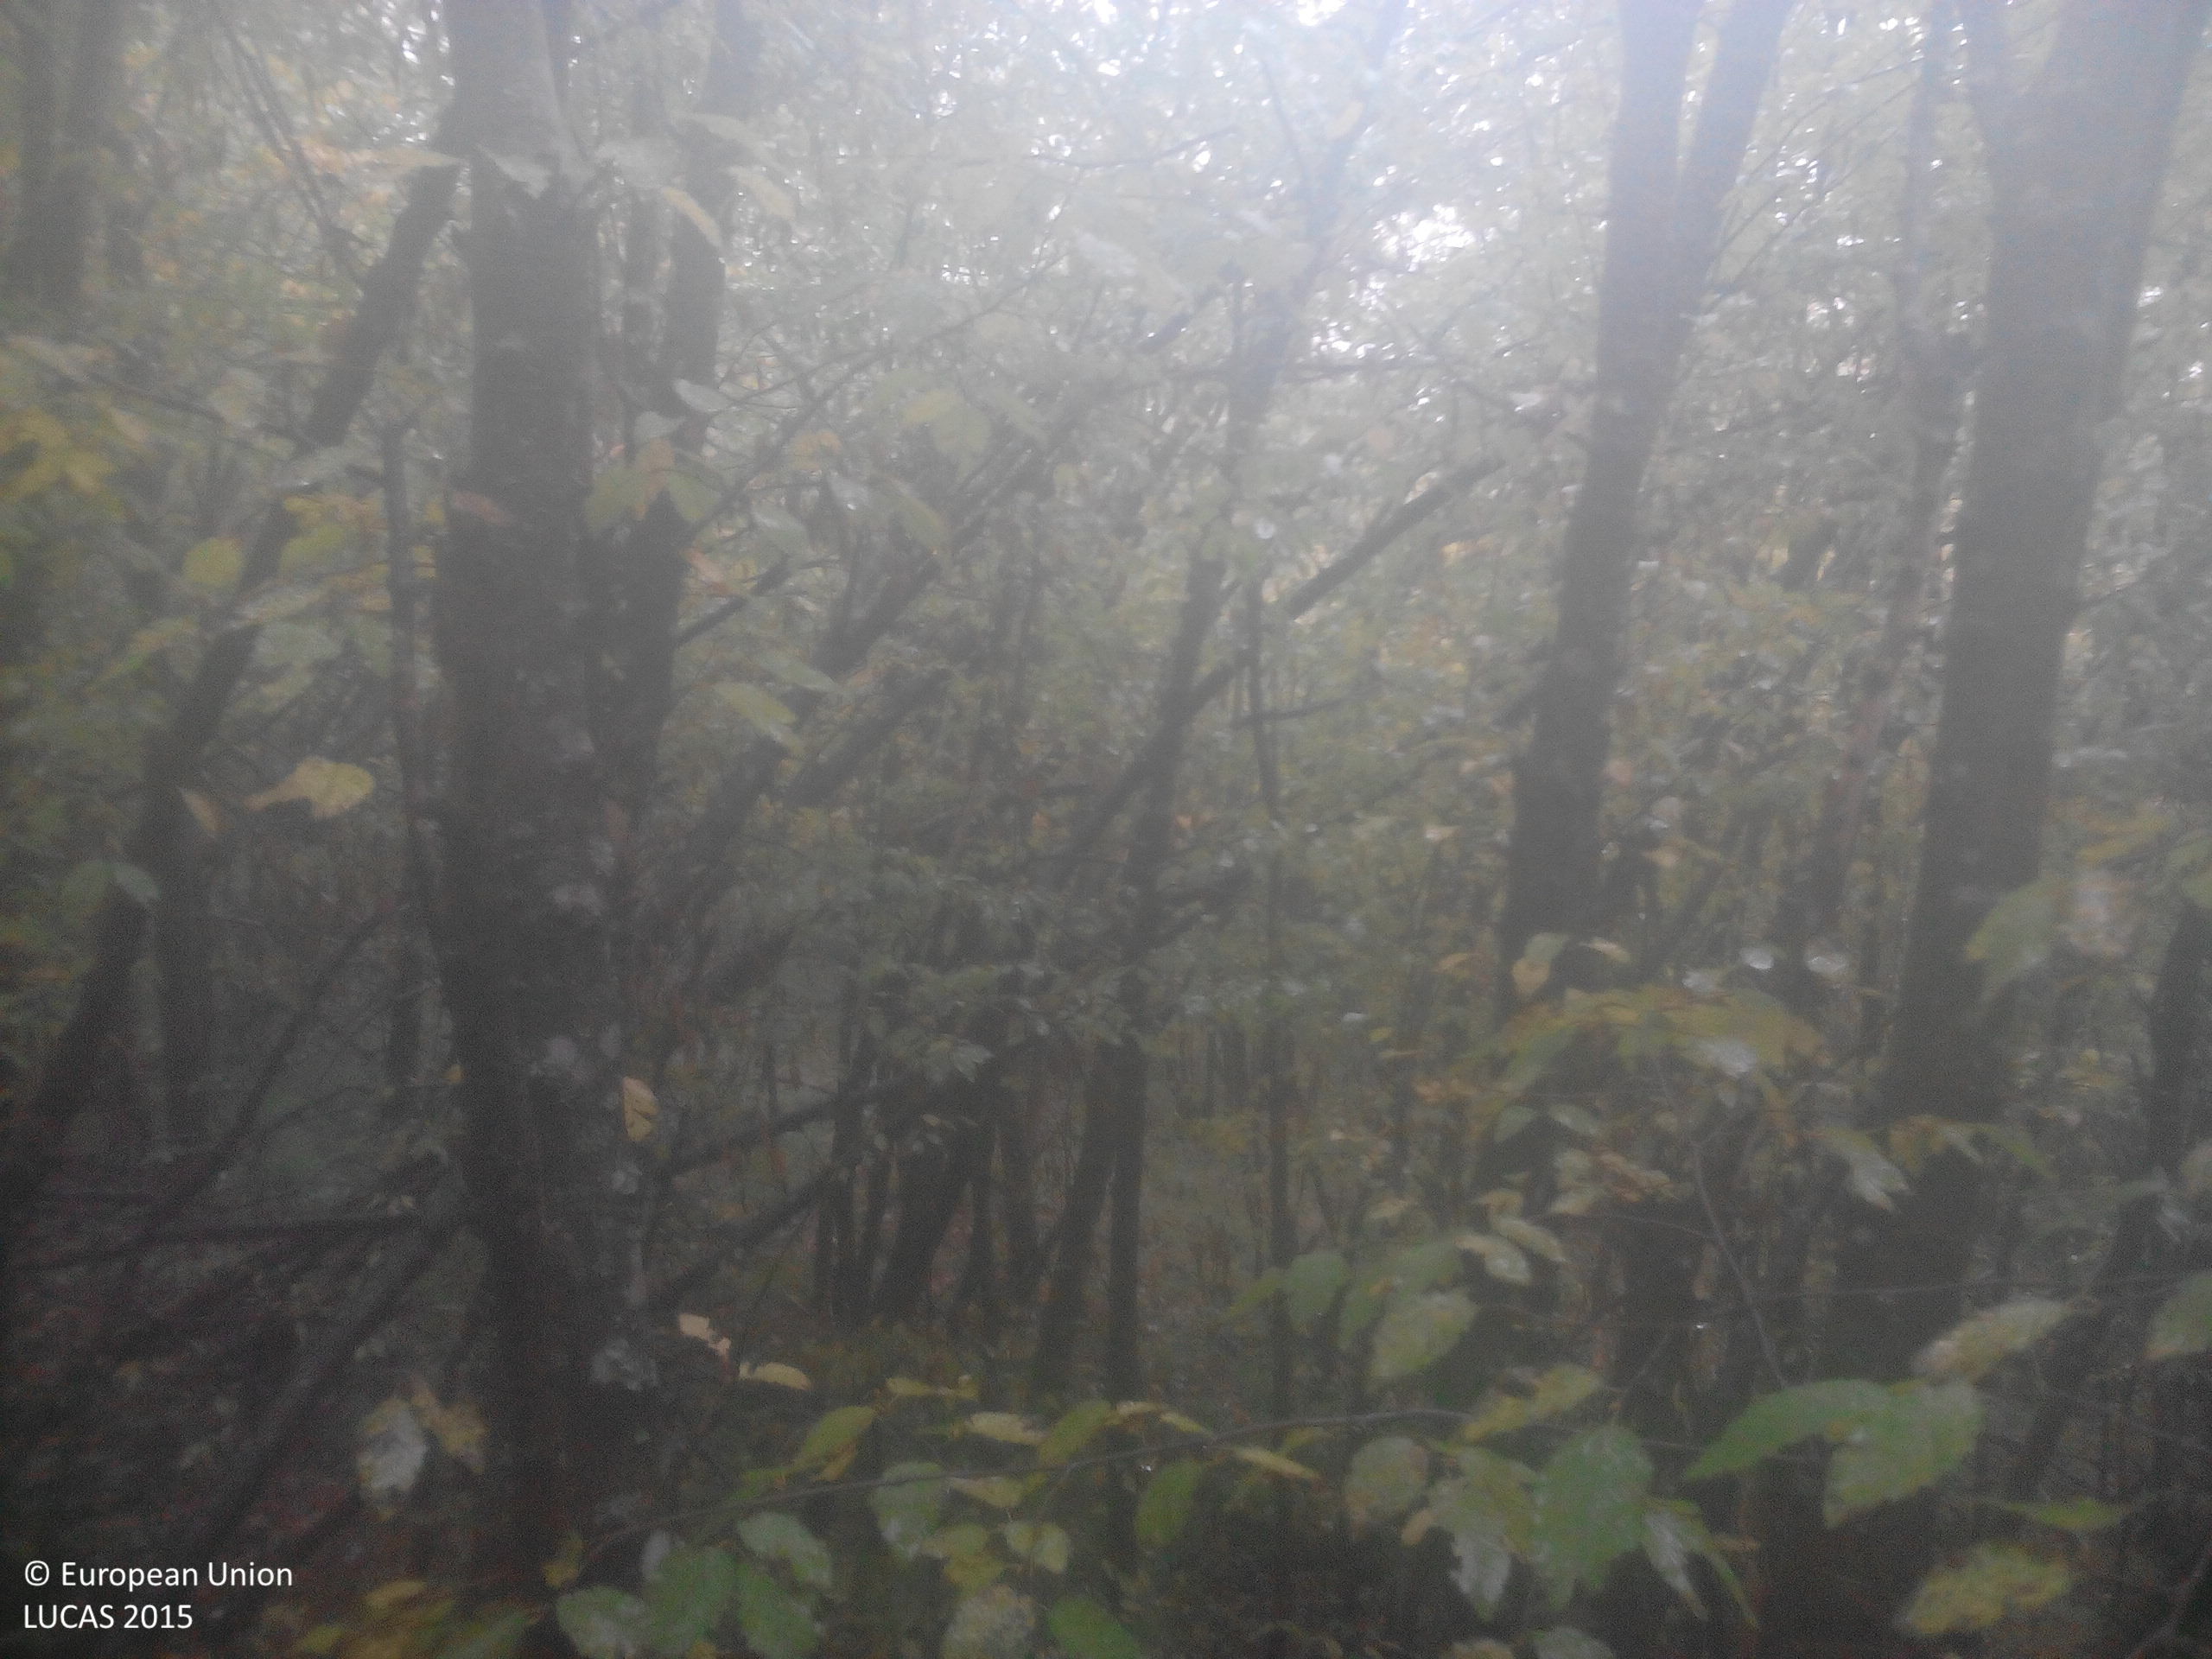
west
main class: Woodland
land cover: Broadleaved woodland
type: beech forest
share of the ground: > 75 %
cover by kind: broadleaved forest trees 100 %
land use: Forestry
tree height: > 5 m
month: October
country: BG
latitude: 43.0485
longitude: 24.1316
